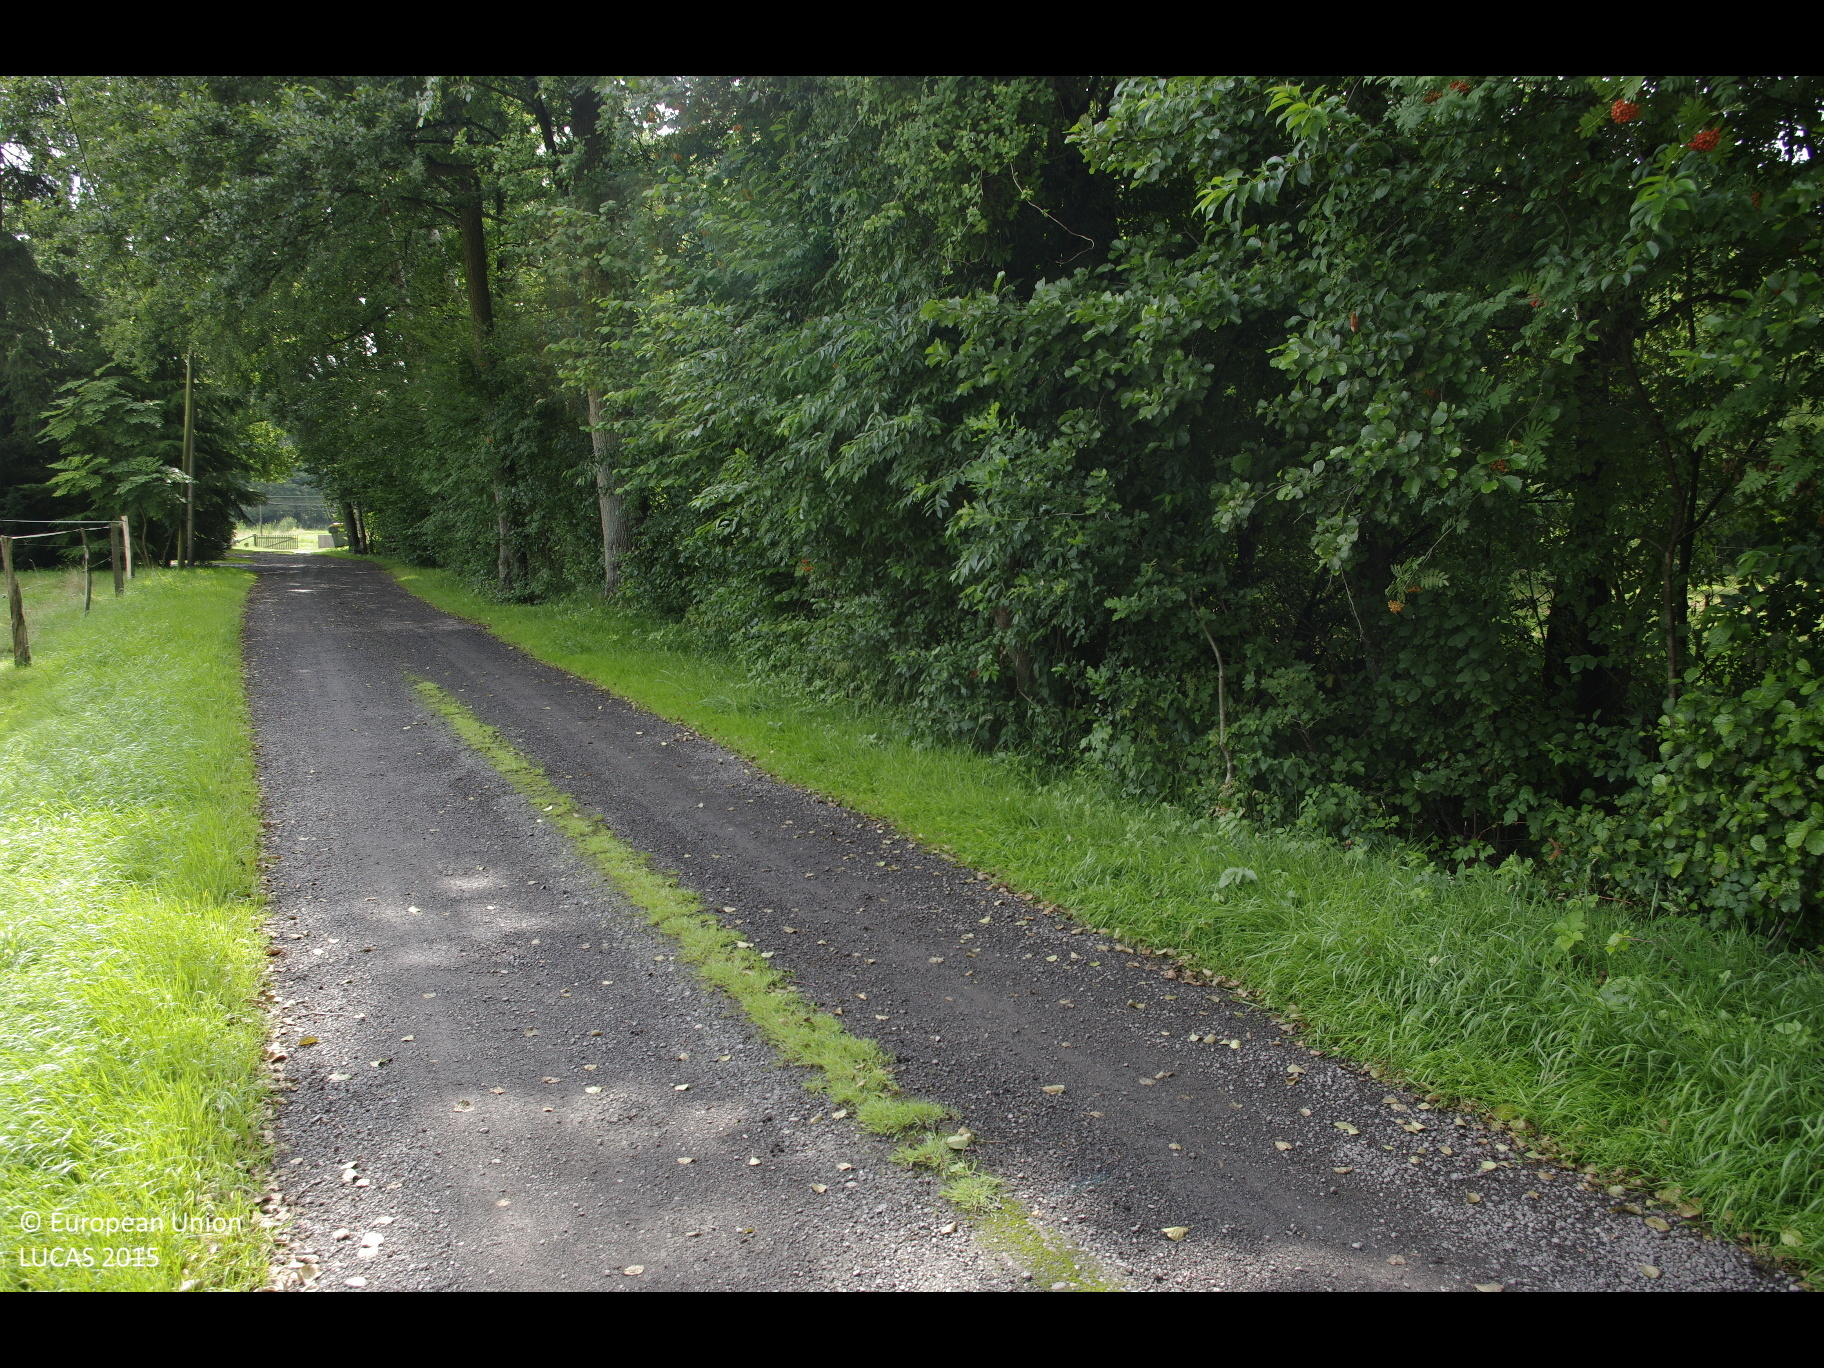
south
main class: Grassland
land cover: Grassland without tree/shrub cover
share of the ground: > 75 %
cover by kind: herbaceous plants 100 %
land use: Agriculture (excluding fallow land and kitchen gardens)
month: August
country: DE
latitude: 53.2581
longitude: 9.8652
